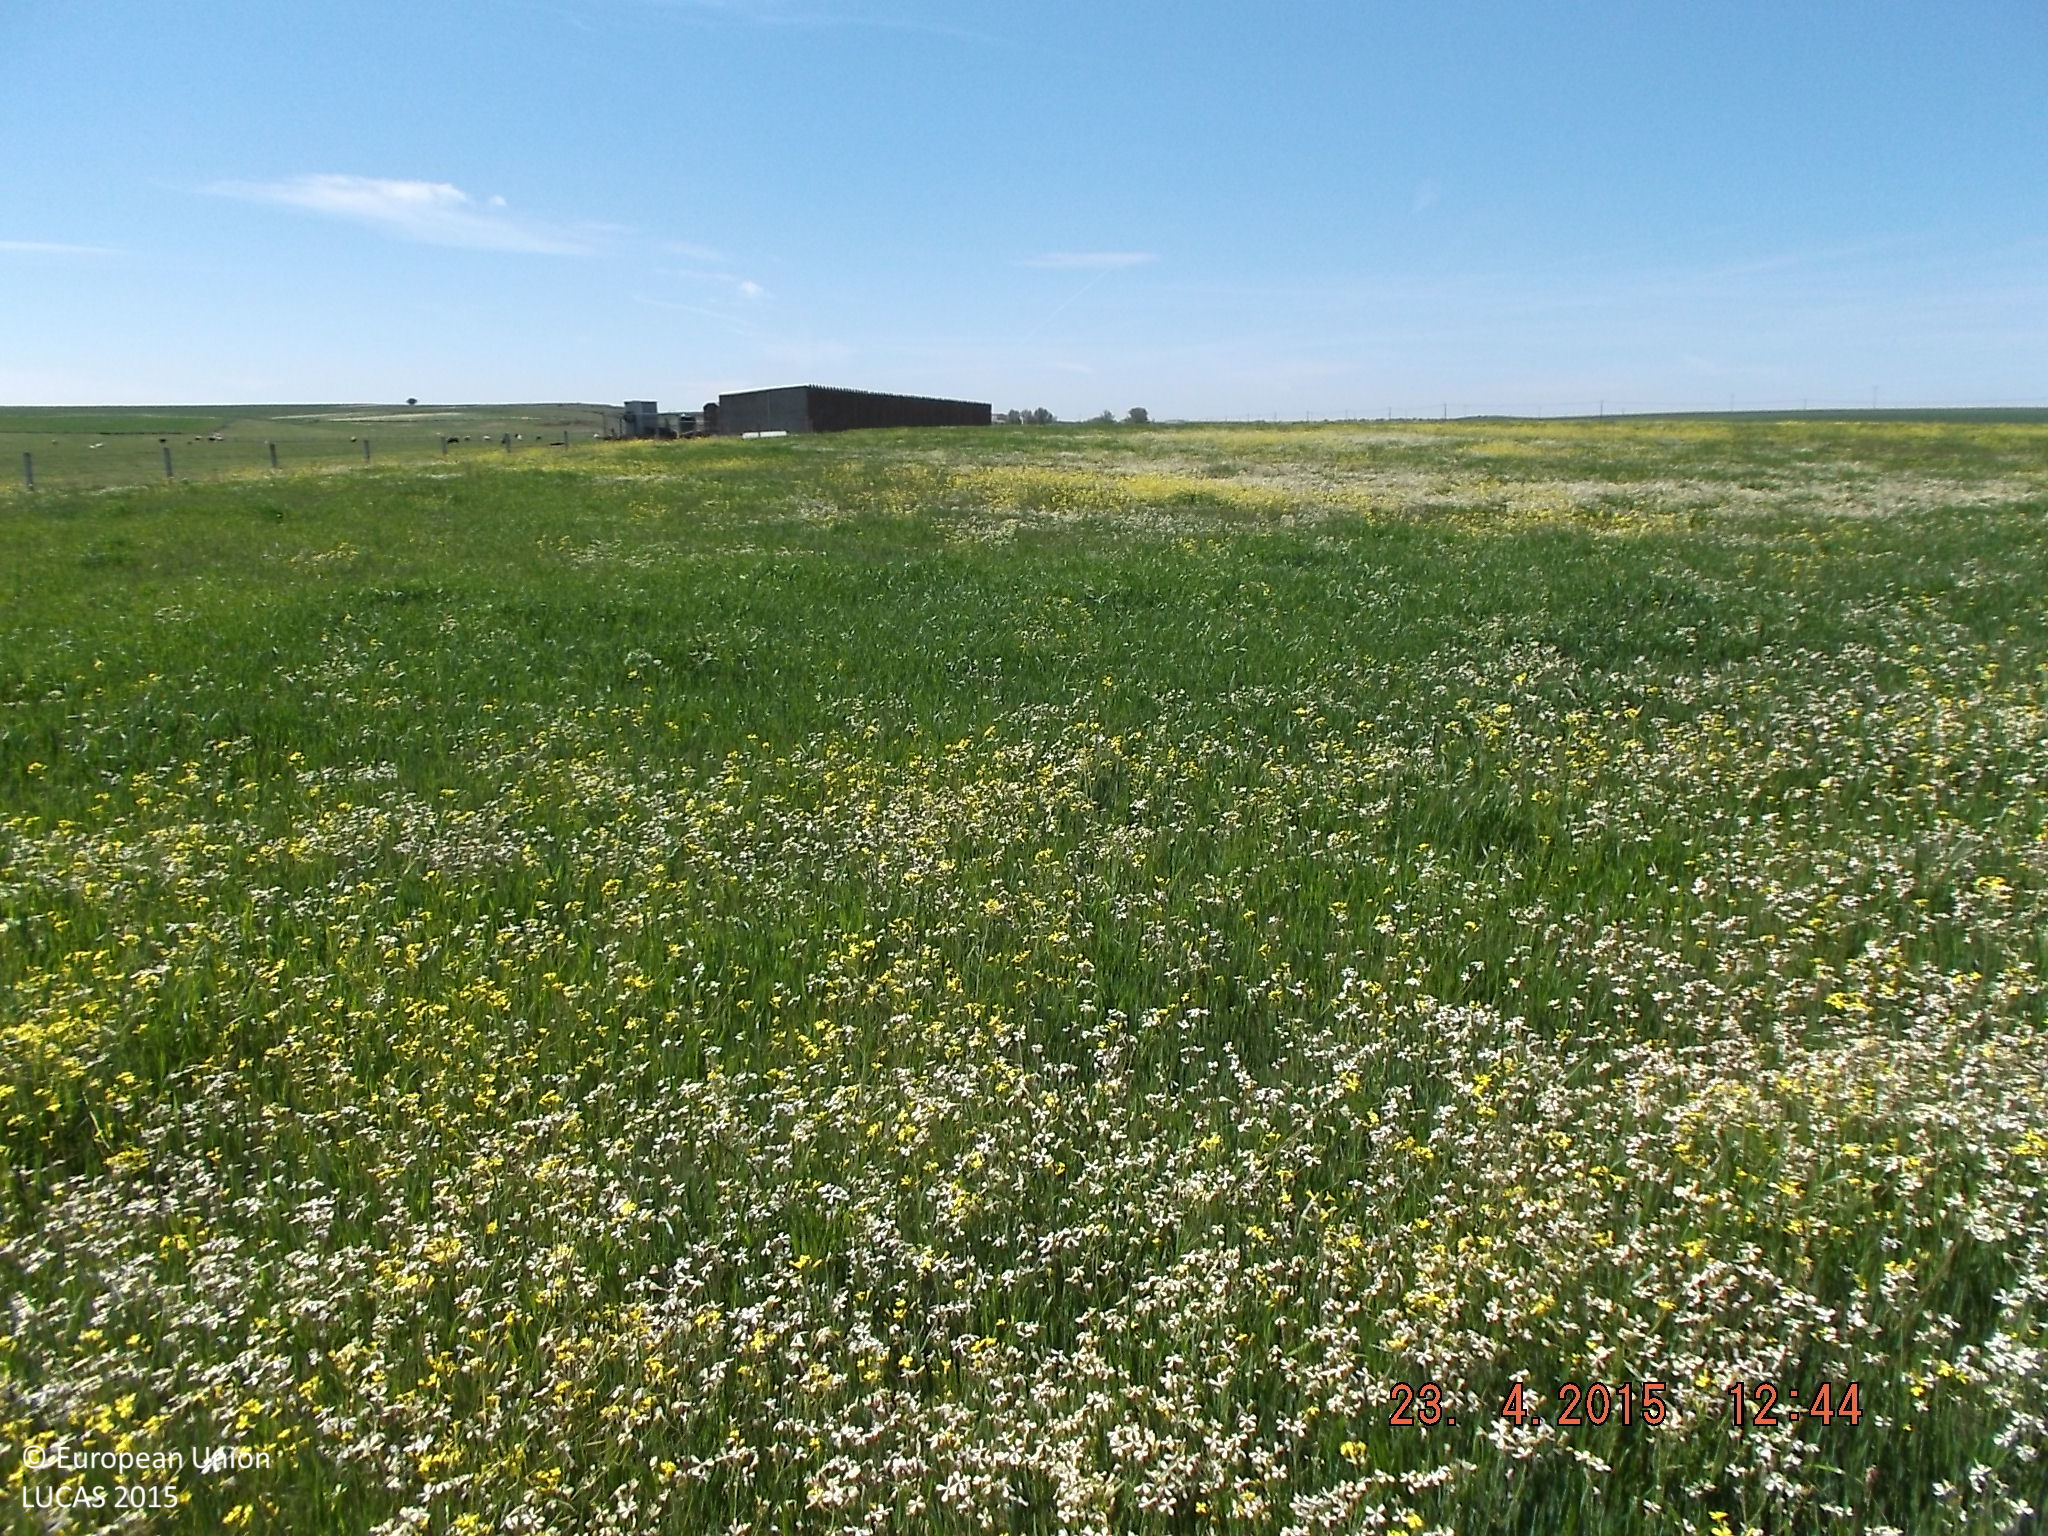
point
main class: Grassland
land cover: Grassland without tree/shrub cover
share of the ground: > 75 %
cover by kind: herbaceous plants 100 %
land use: Agriculture (excluding fallow land and kitchen gardens)
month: April
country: ES
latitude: 40.9841
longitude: -5.9020
